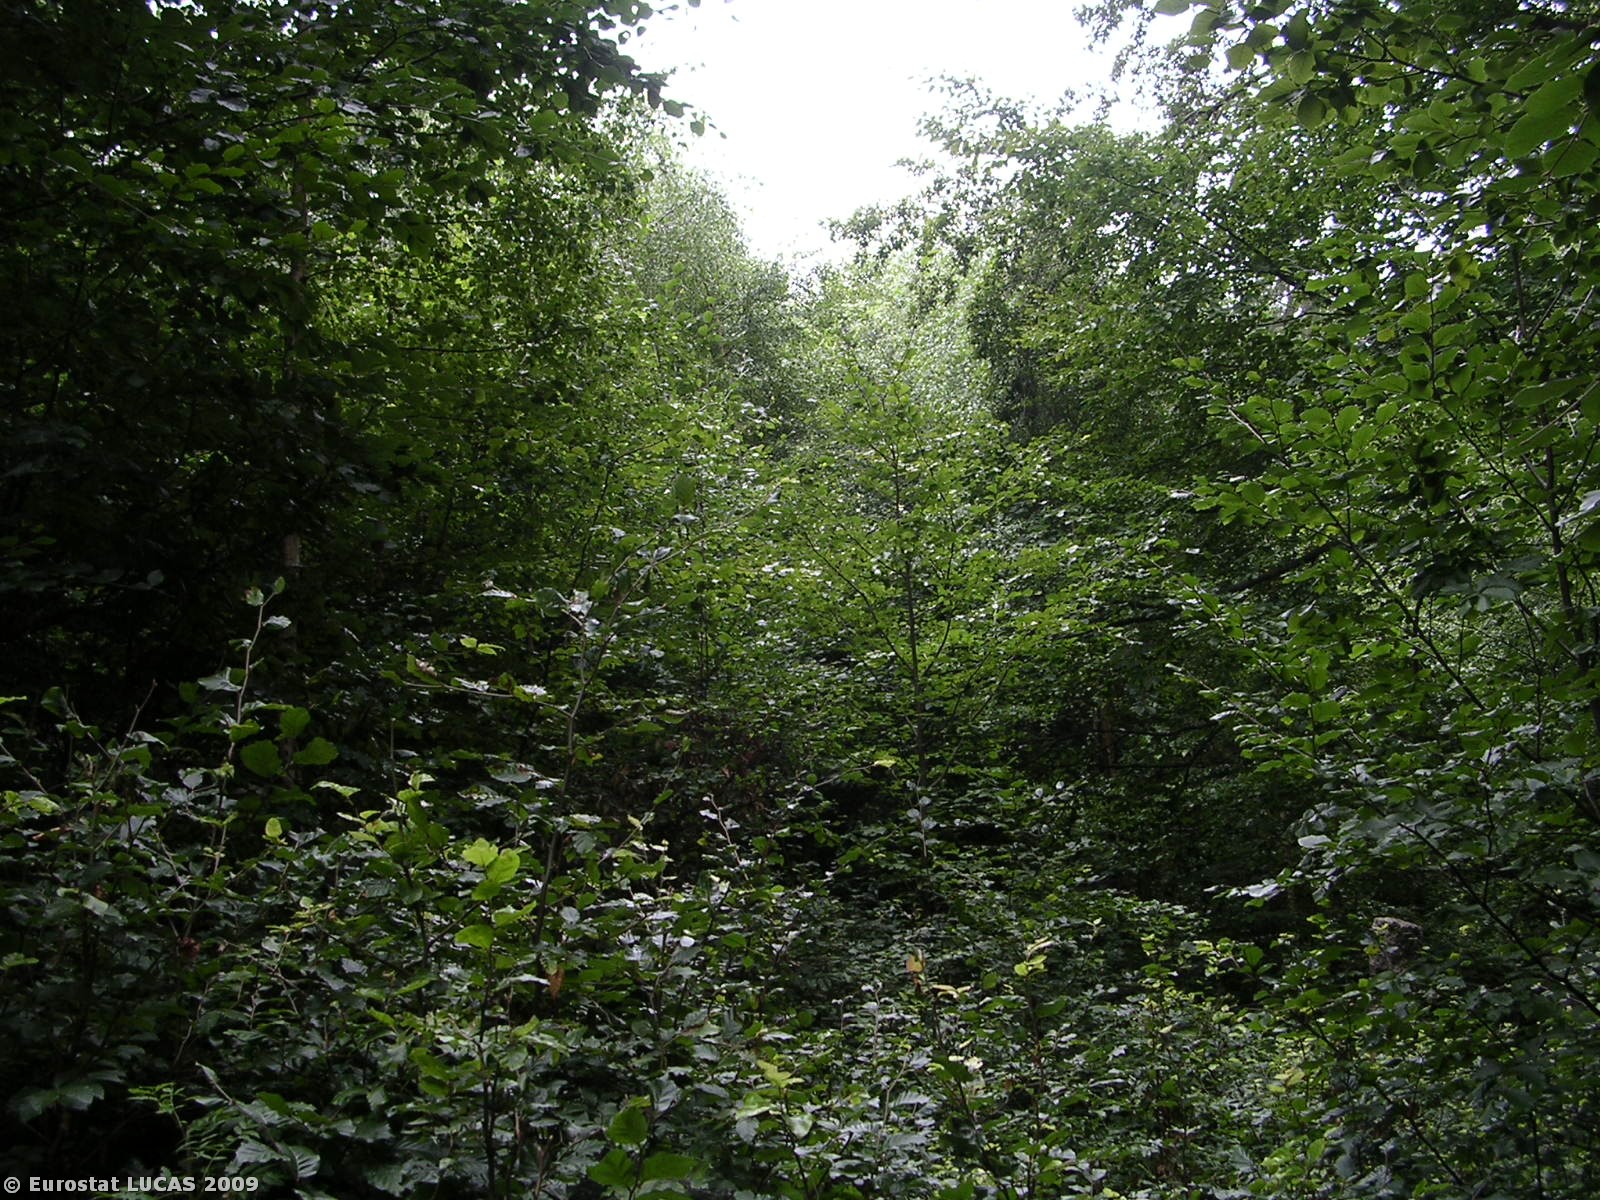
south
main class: Woodland
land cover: Mixed woodland
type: hemiboreal forest and nemoral coniferous forest and mixed broadleaved-coniferous forest
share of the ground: > 75 %
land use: Forestry
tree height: > 5 m
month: July
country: CZ
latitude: 50.8102
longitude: 15.0695
